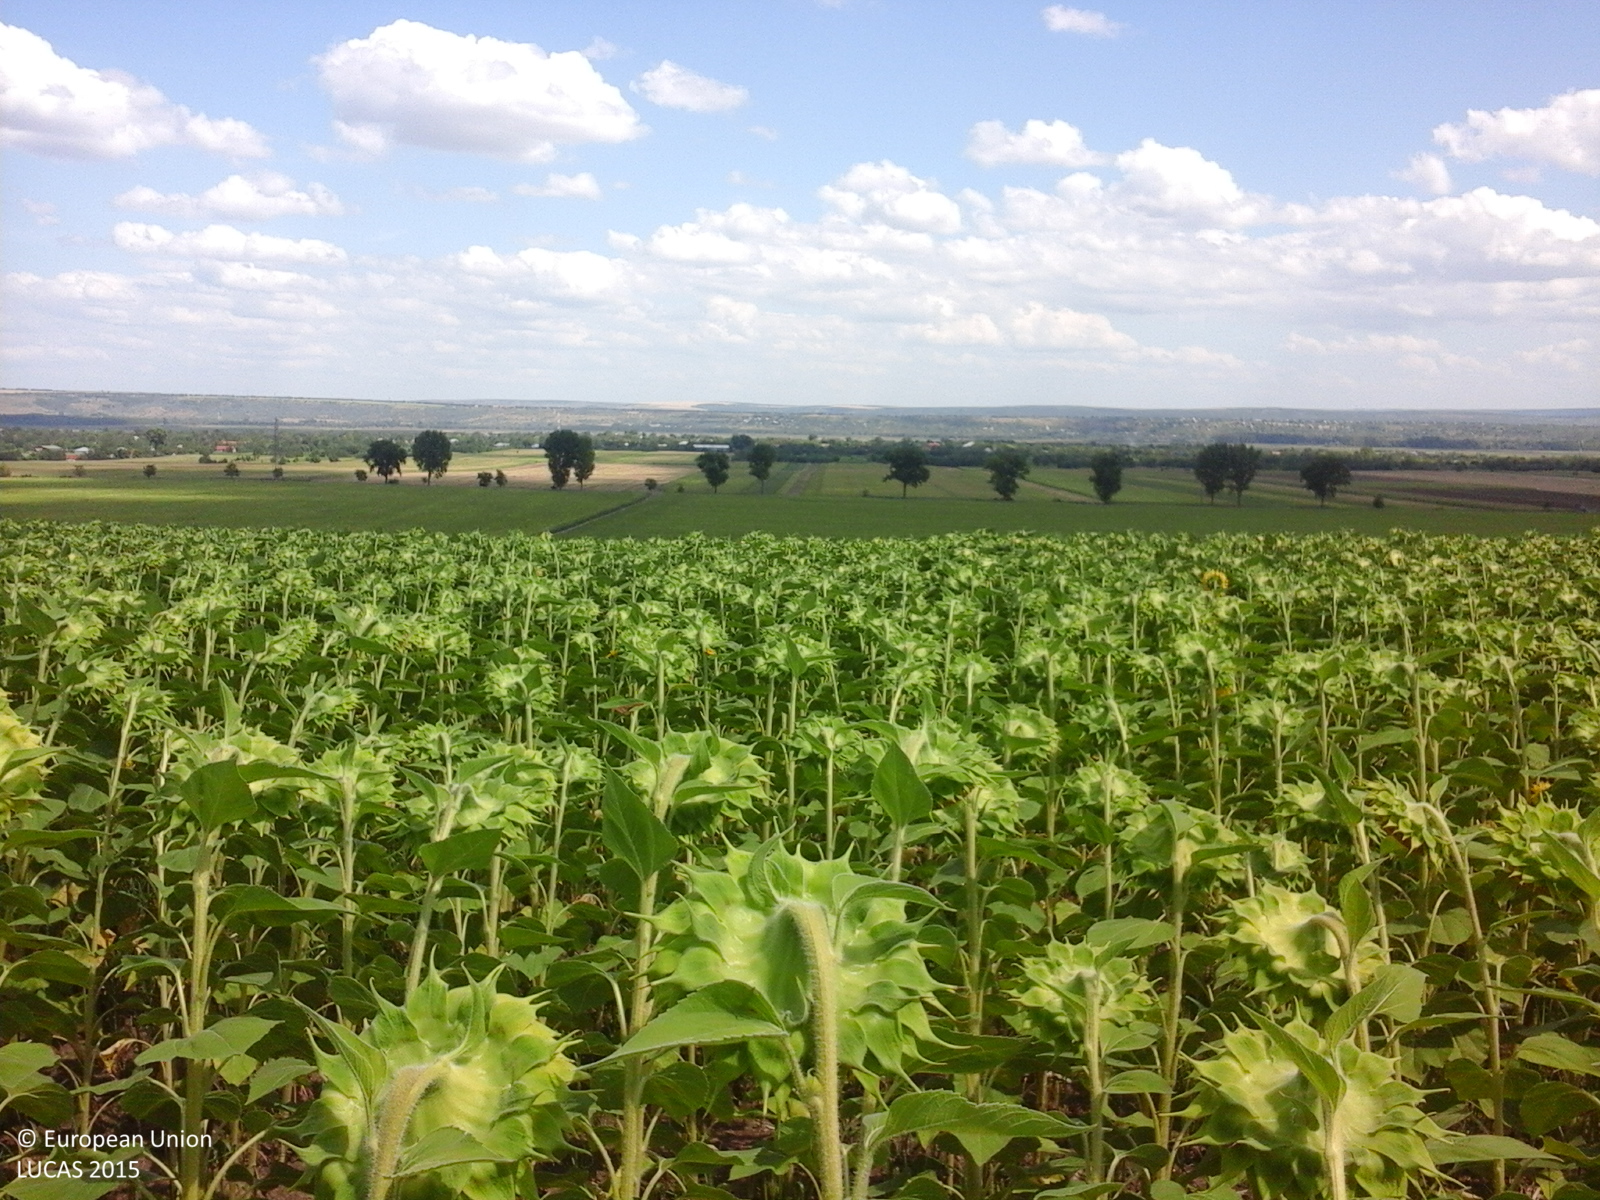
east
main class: Cropland
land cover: Sunflower
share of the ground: > 75 %
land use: Agriculture (excluding fallow land and kitchen gardens)
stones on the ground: < 10 %
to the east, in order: Sunflower
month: July
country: RO
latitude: 46.4356
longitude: 28.1836
